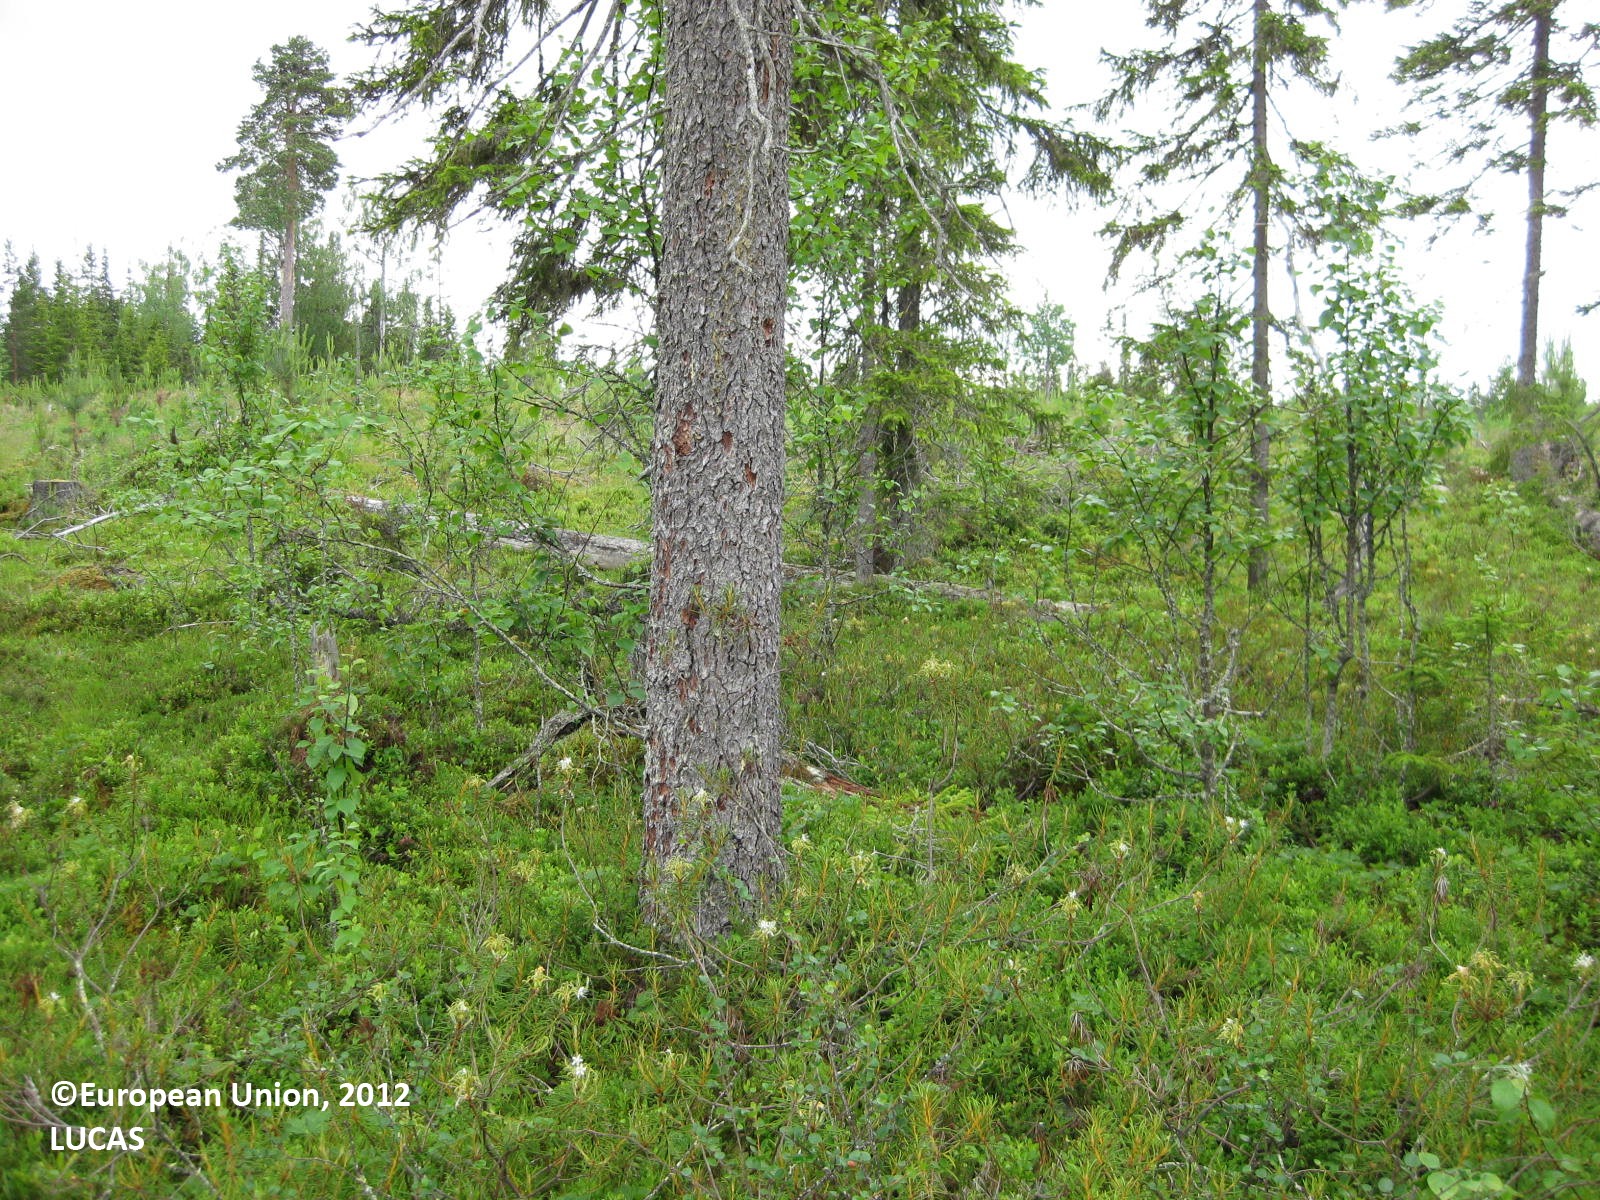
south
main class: Woodland
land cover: Spruce dominated coniferous woodland
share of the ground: 25 - 50 %
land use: Forestry
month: July
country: FI
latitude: 65.4562
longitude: 28.3894
